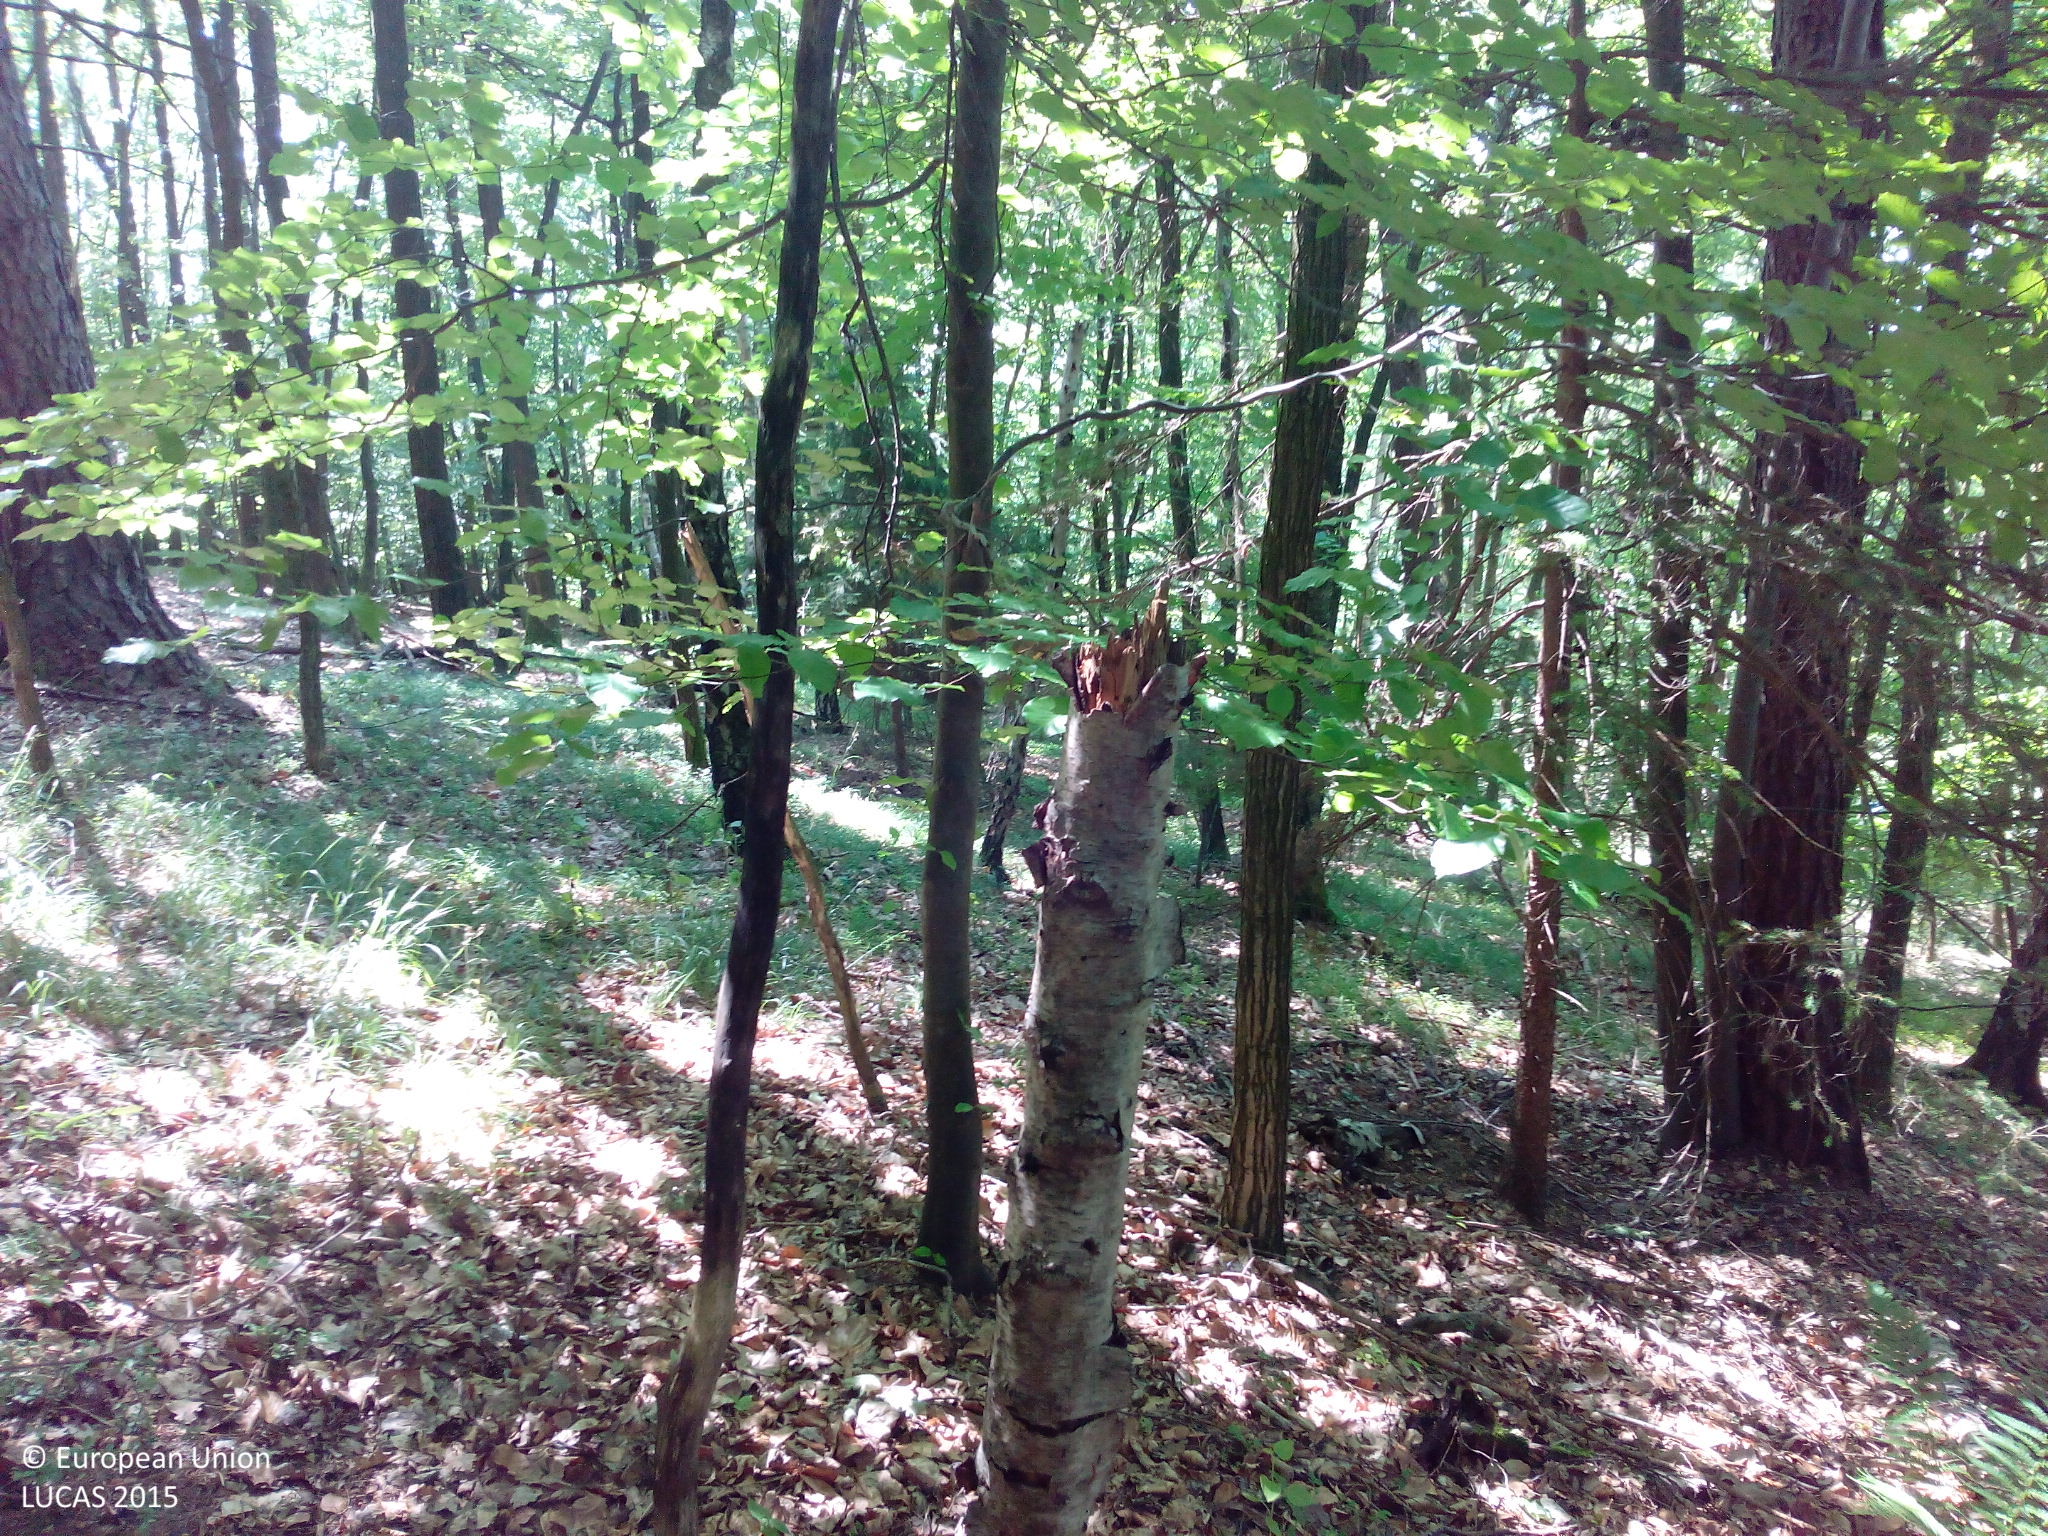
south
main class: Woodland
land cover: Pine dominated mixed woodland
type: hemiboreal forest and nemoral coniferous forest and mixed broadleaved-coniferous forest
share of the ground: > 75 %
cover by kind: broadleaved forest trees 60 %, coniferous forest trees 30 %, herbaceous plants 5 %, unconsolidated bare surface 5 %
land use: Forestry
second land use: Amenities, museums, leisure
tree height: > 5 m
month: July
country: DE
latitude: 49.8195
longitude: 11.0699
